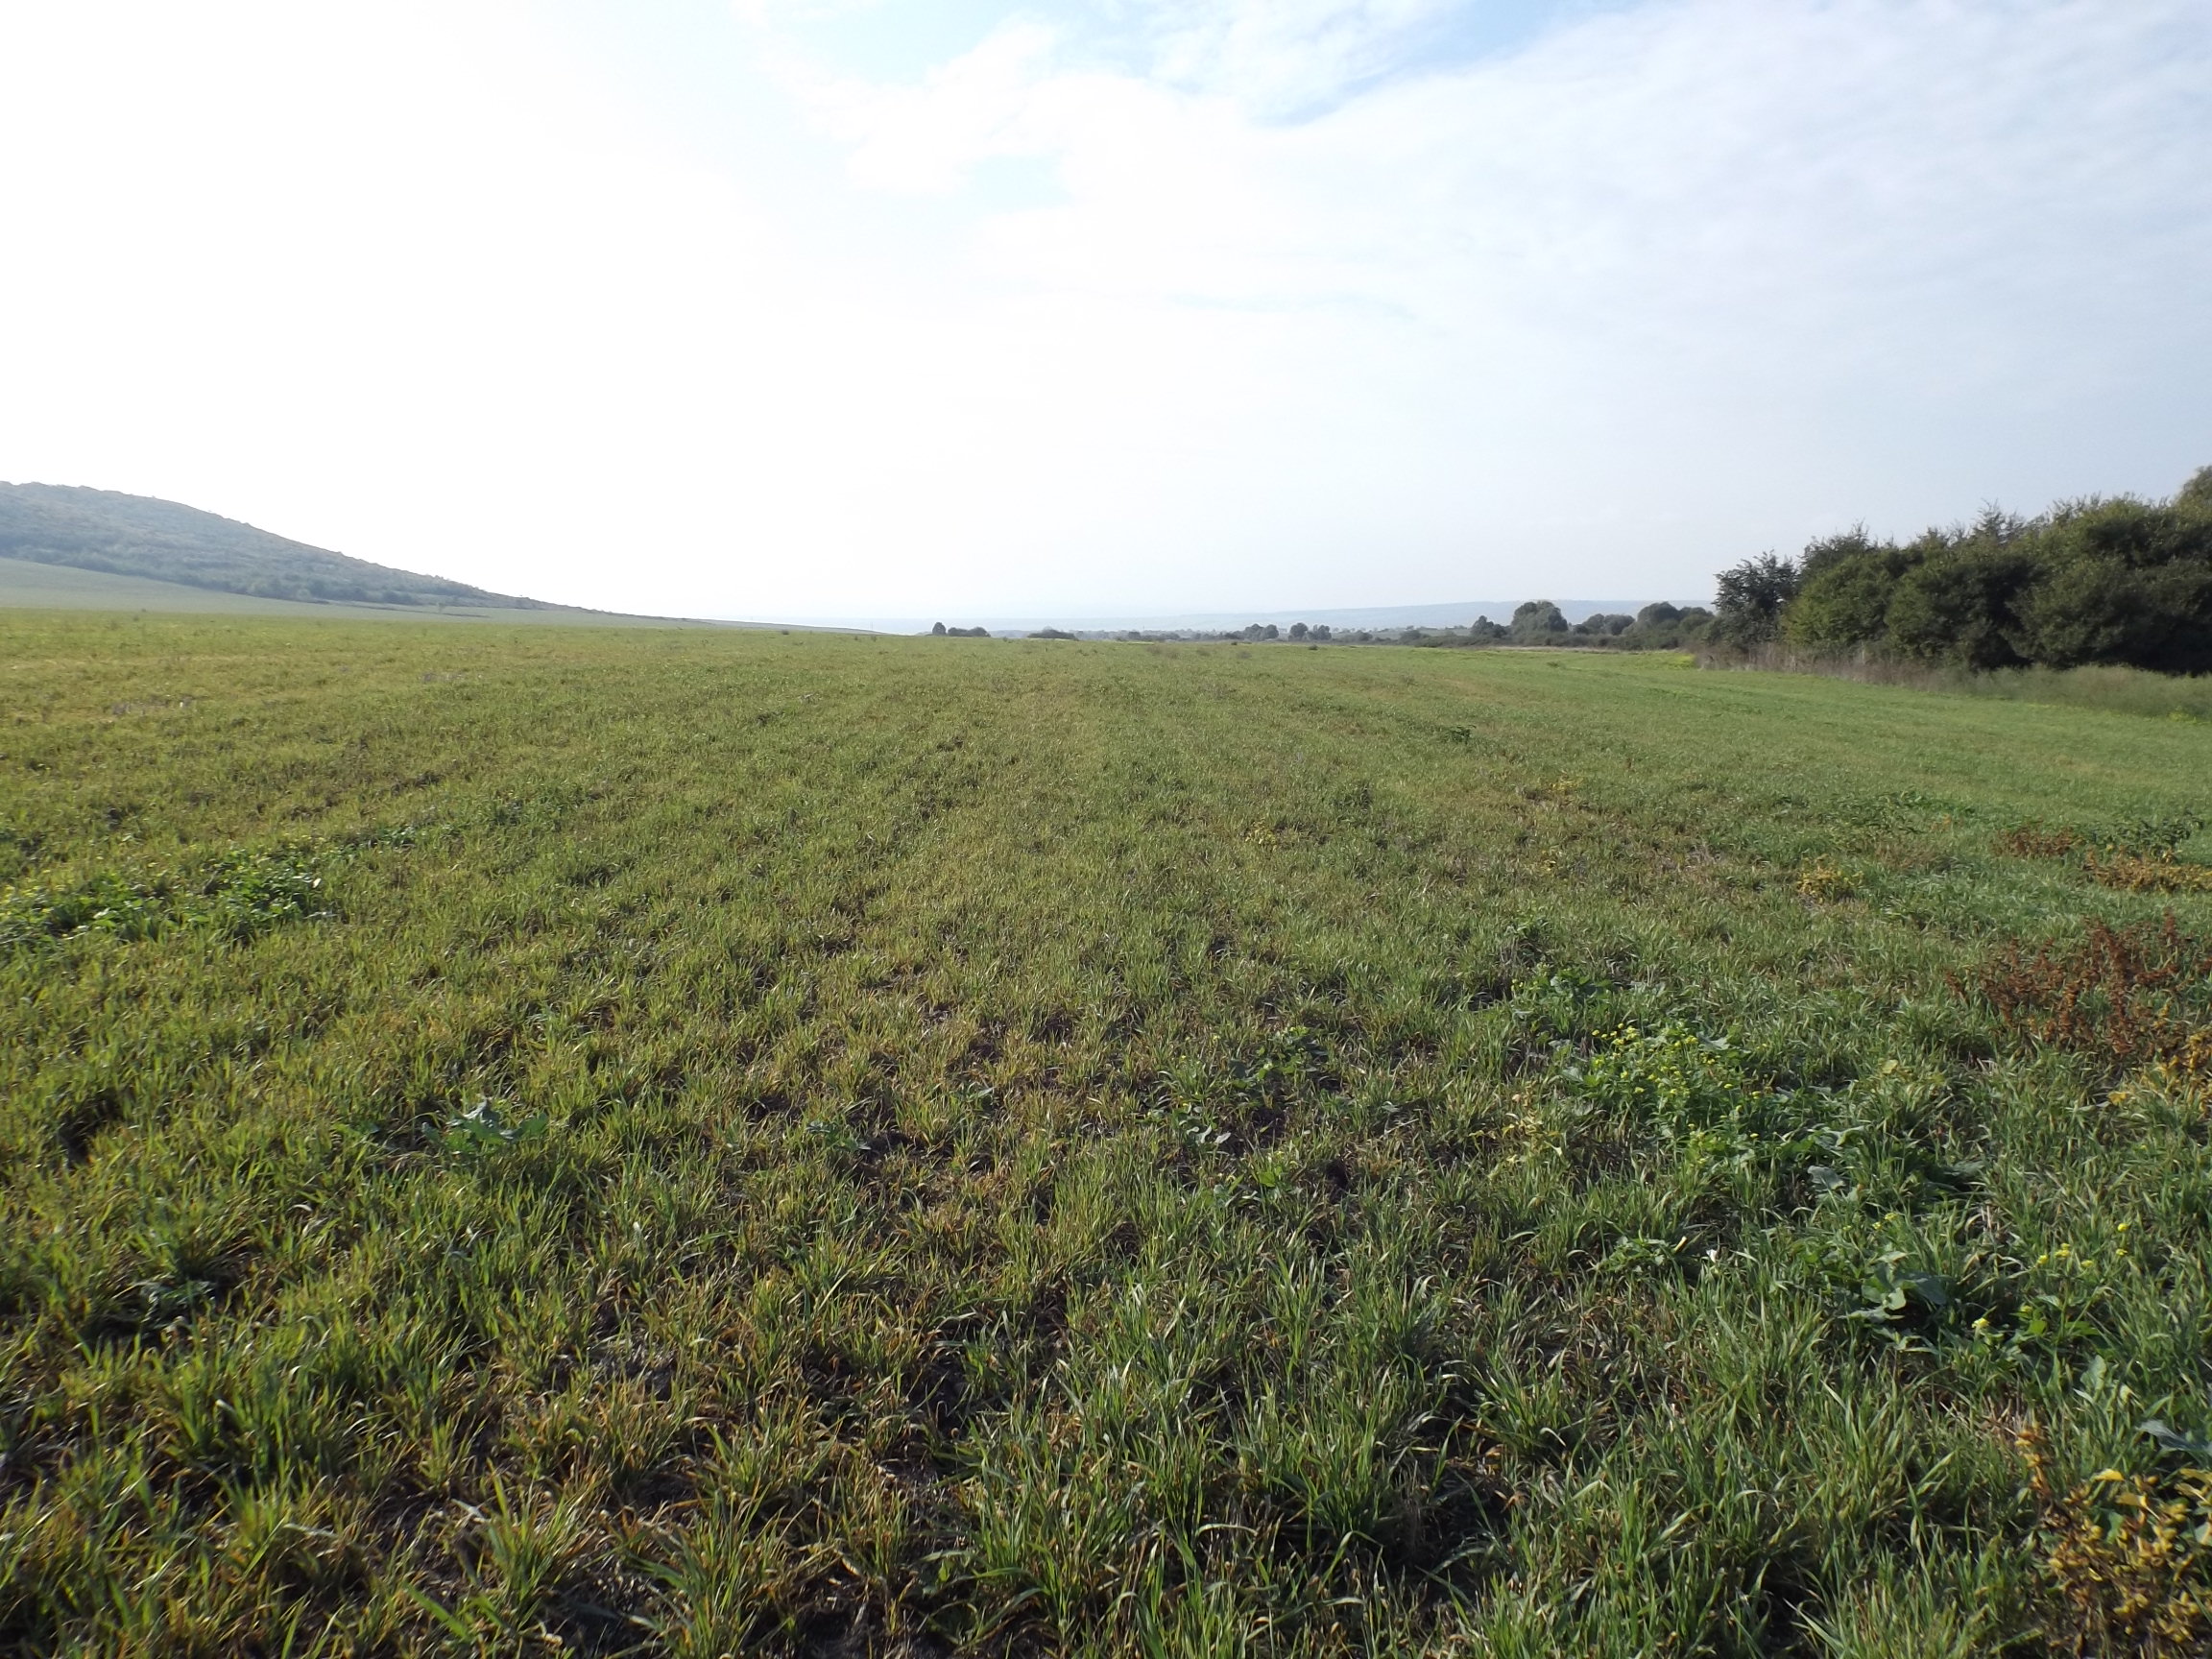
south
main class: Cropland
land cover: Common wheat
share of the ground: < 10 %
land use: Agriculture (excluding fallow land and kitchen gardens)
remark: Harvested field
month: October
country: BG
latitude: 43.1573
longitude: 27.5294
